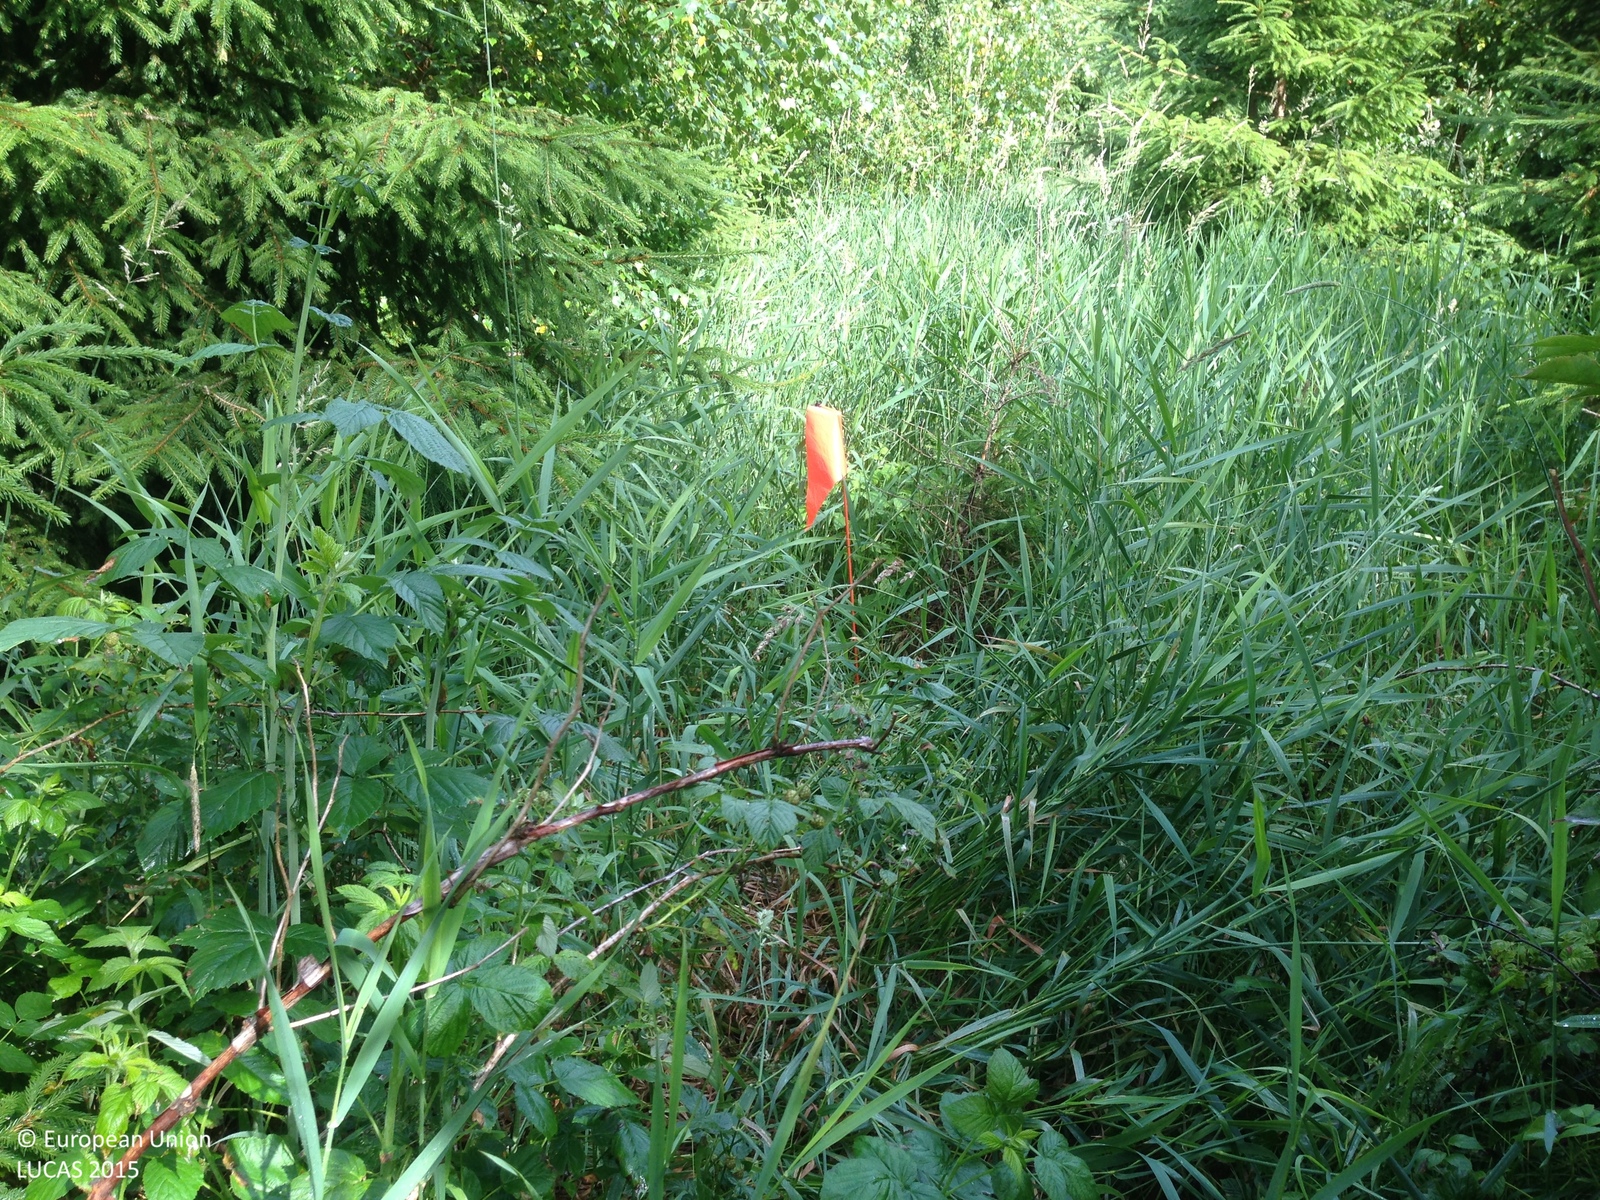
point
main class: Woodland
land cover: Spruce dominated mixed woodland
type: boreal forest
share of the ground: 25 - 50 %
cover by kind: herbaceous plants 60 %, coniferous forest trees 30 %, broadleaved forest trees 10 %
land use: Forestry
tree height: > 5 m
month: July
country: SE
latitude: 59.9177
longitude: 18.6017
